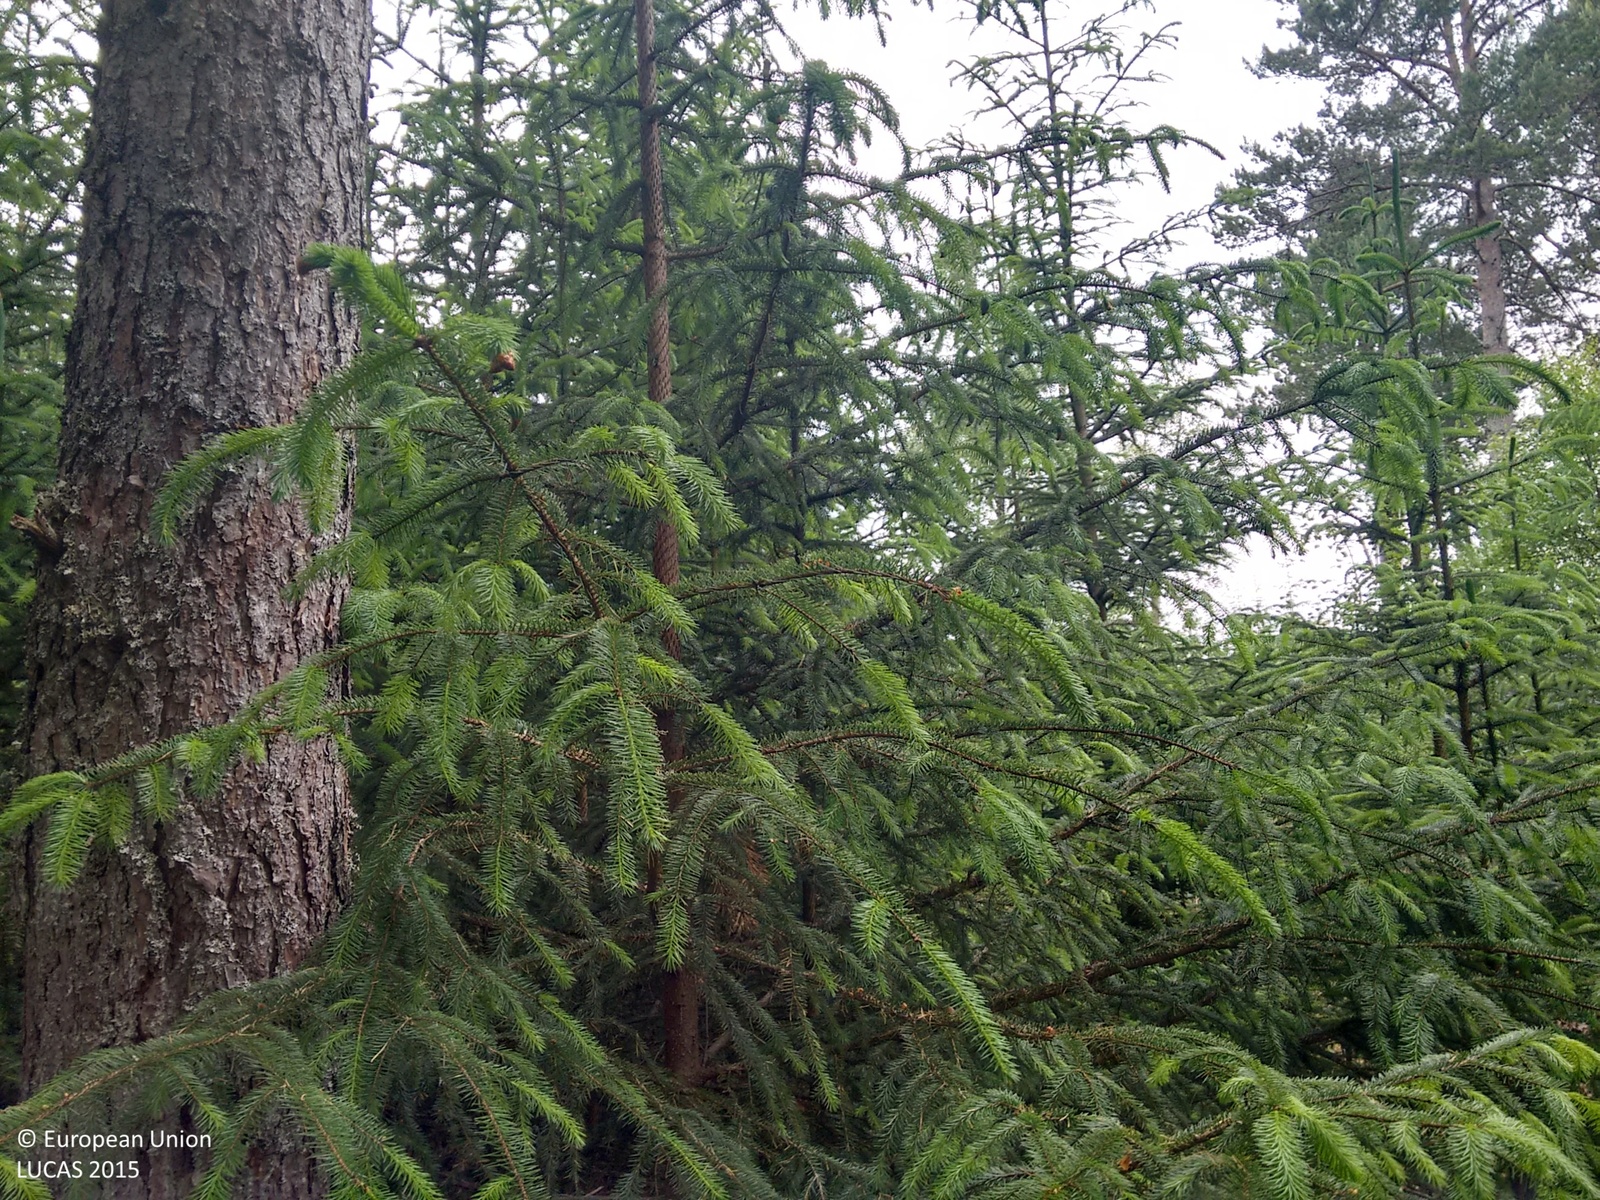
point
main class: Woodland
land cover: Spruce dominated coniferous woodland
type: exotic forest
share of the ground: > 75 %
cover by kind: coniferous forest trees 85 %, broadleaved forest trees 15 %
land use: Forestry
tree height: > 5 m
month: July
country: GB
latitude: 56.6829
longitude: -4.2758
